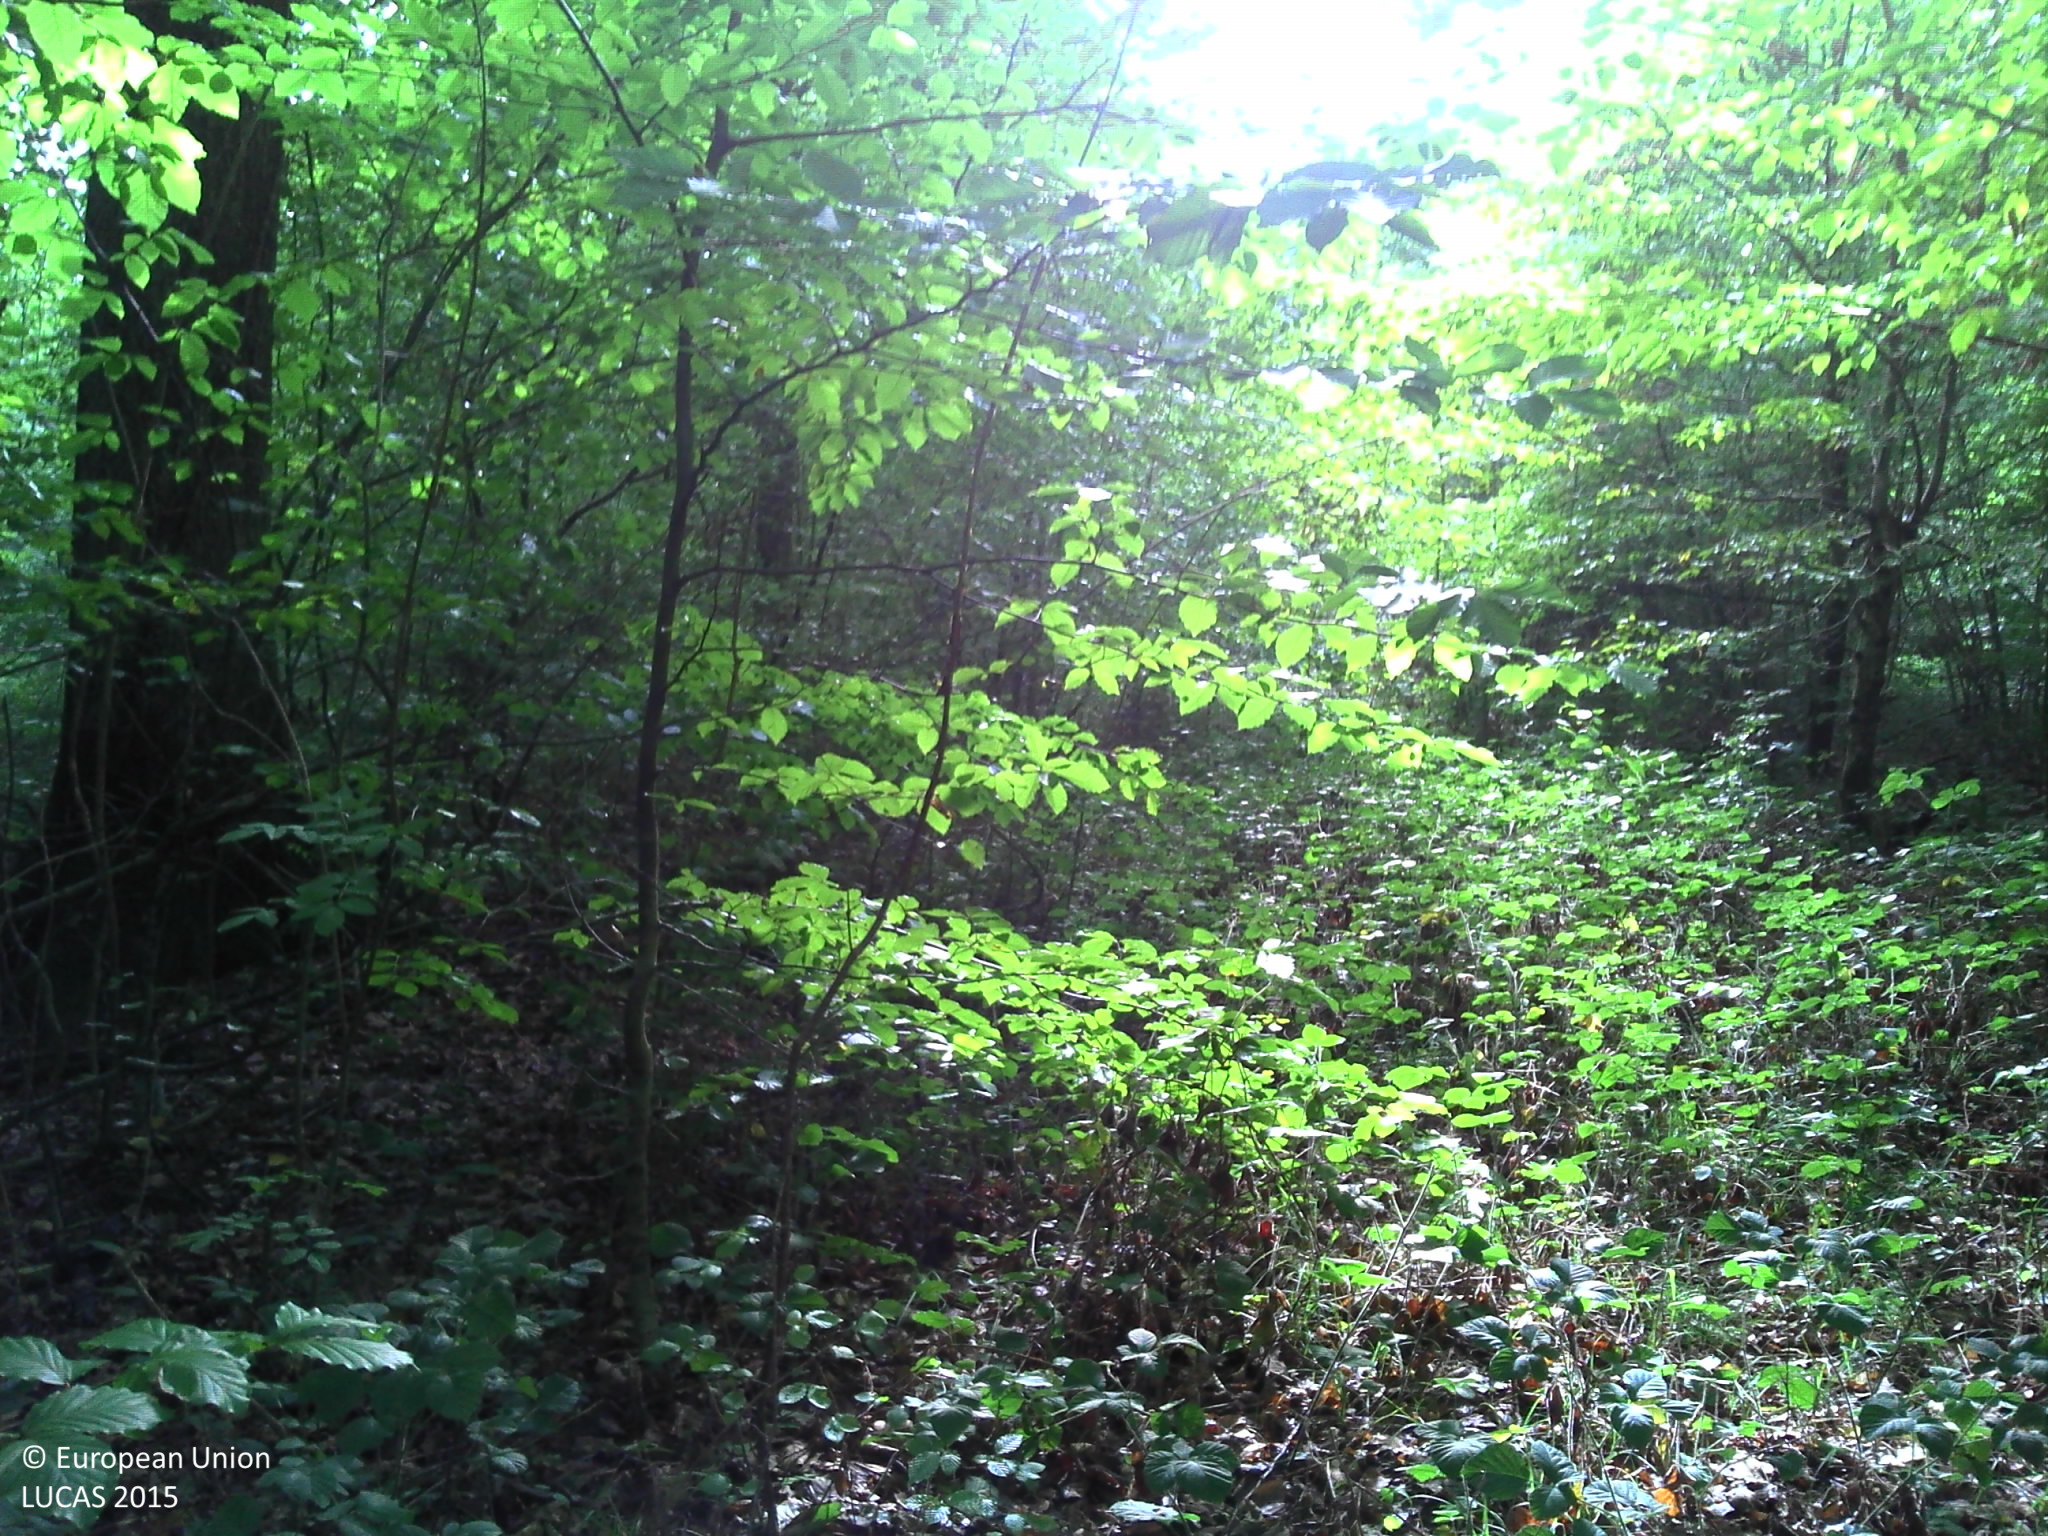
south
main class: Woodland
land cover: Broadleaved woodland
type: mesophytic deciduous forest
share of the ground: > 75 %
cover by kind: broadleaved forest trees 90 %, herbaceous plants 5 %, consolidated bare surface 5 %
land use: Forestry
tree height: > 5 m
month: September
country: FR
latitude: 48.8538
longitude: 6.0064
